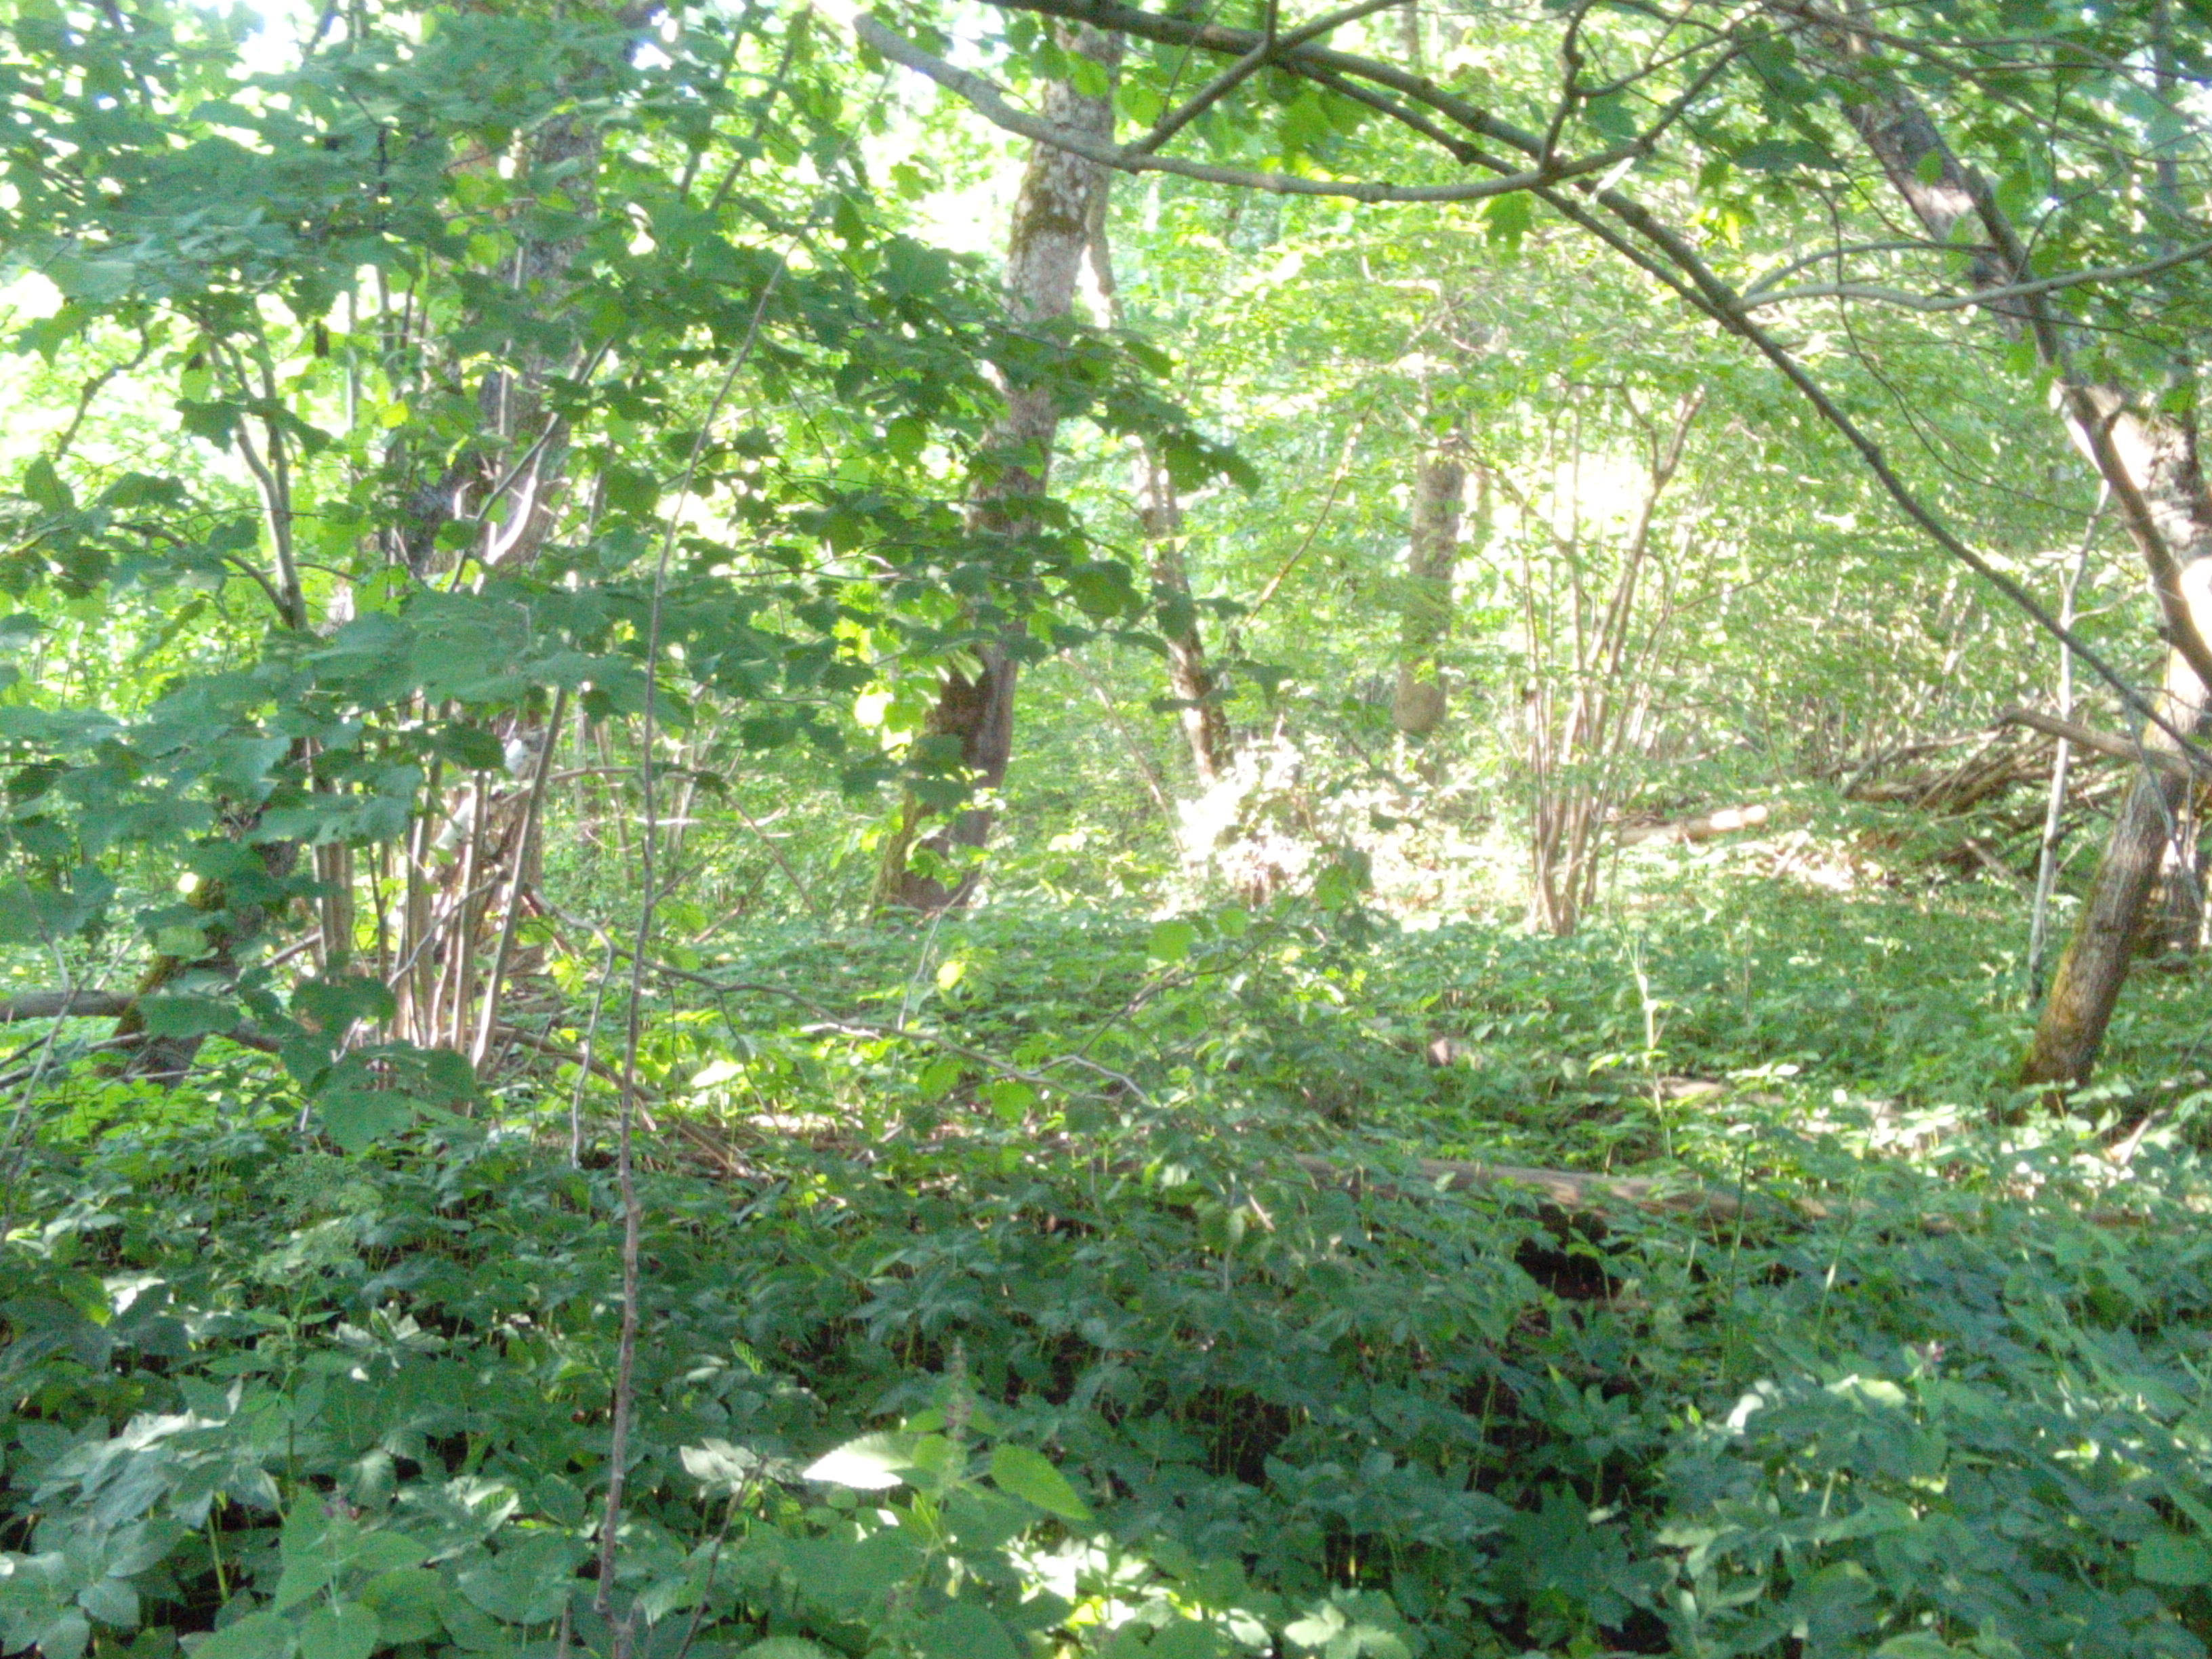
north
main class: Woodland
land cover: Broadleaved woodland
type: non-riverine alder, birch or aspen forest
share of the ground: > 75 %
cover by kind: broadleaved forest trees 85 %, herbaceous plants 10 %, shrubs 5 %
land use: Forestry
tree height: > 5 m
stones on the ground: < 10 %
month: July
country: LV
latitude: 56.5118
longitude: 21.8283
